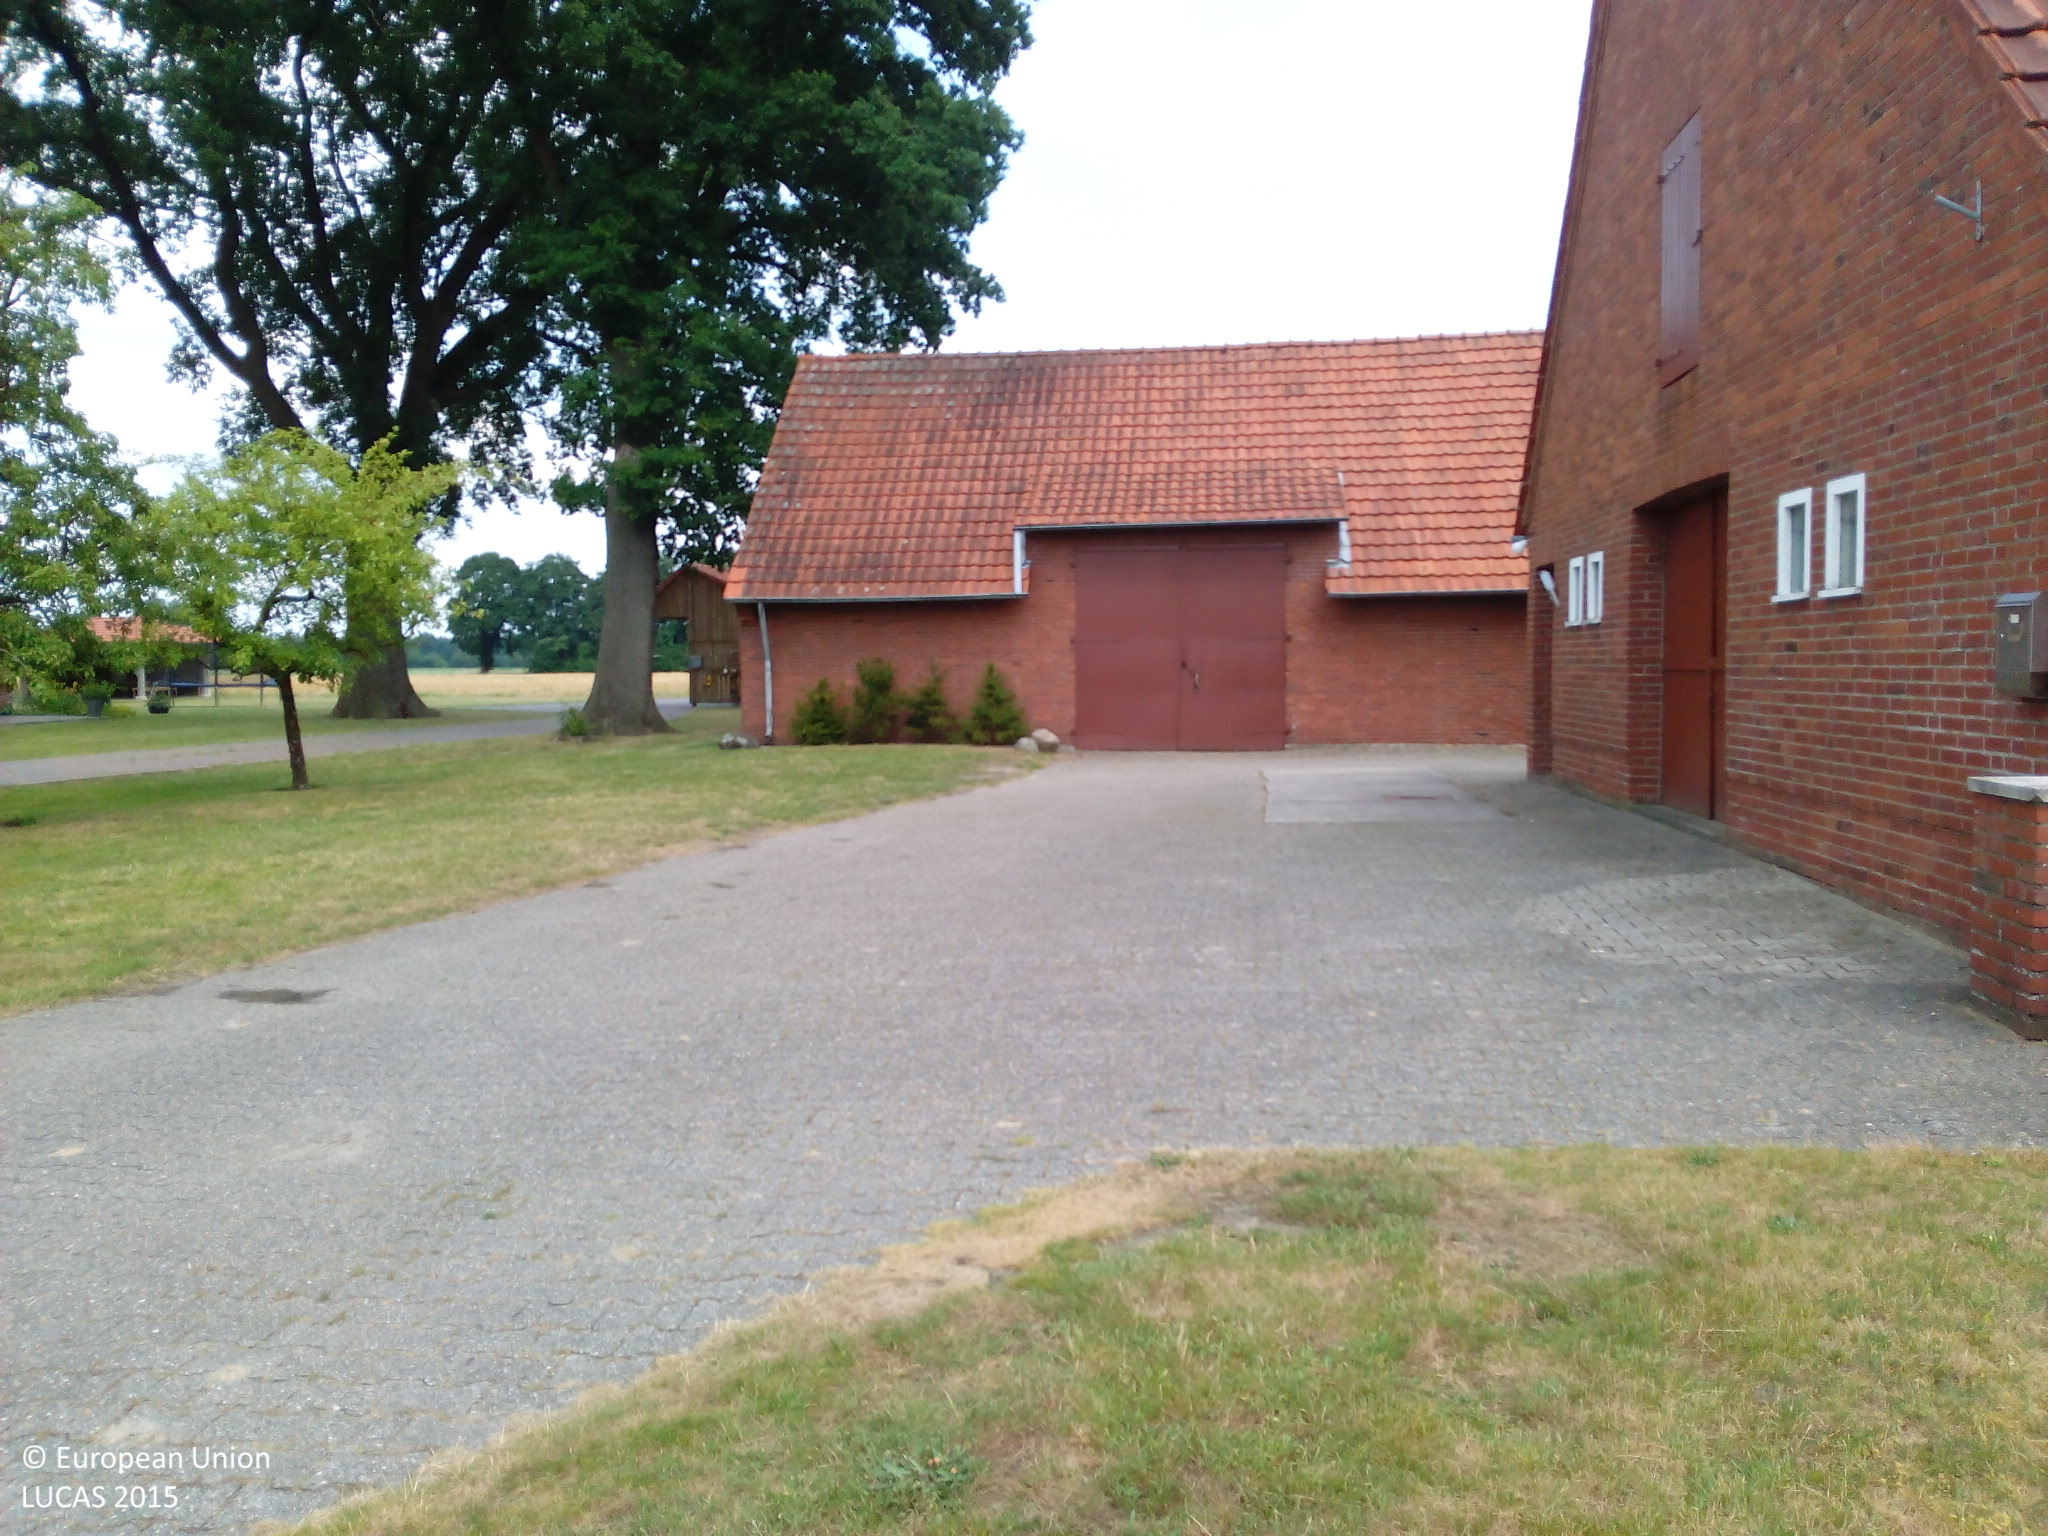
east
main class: Grassland
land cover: Grassland without tree/shrub cover
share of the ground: > 75 %
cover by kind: herbaceous plants 100 %
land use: Residential
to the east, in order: Grassland without tree/shrub cover; Artificial constructions in urban areas; Grassland without tree/shrub cover; Ditches and canals; Barley
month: July
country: DE
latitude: 52.6717
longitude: 7.3532
